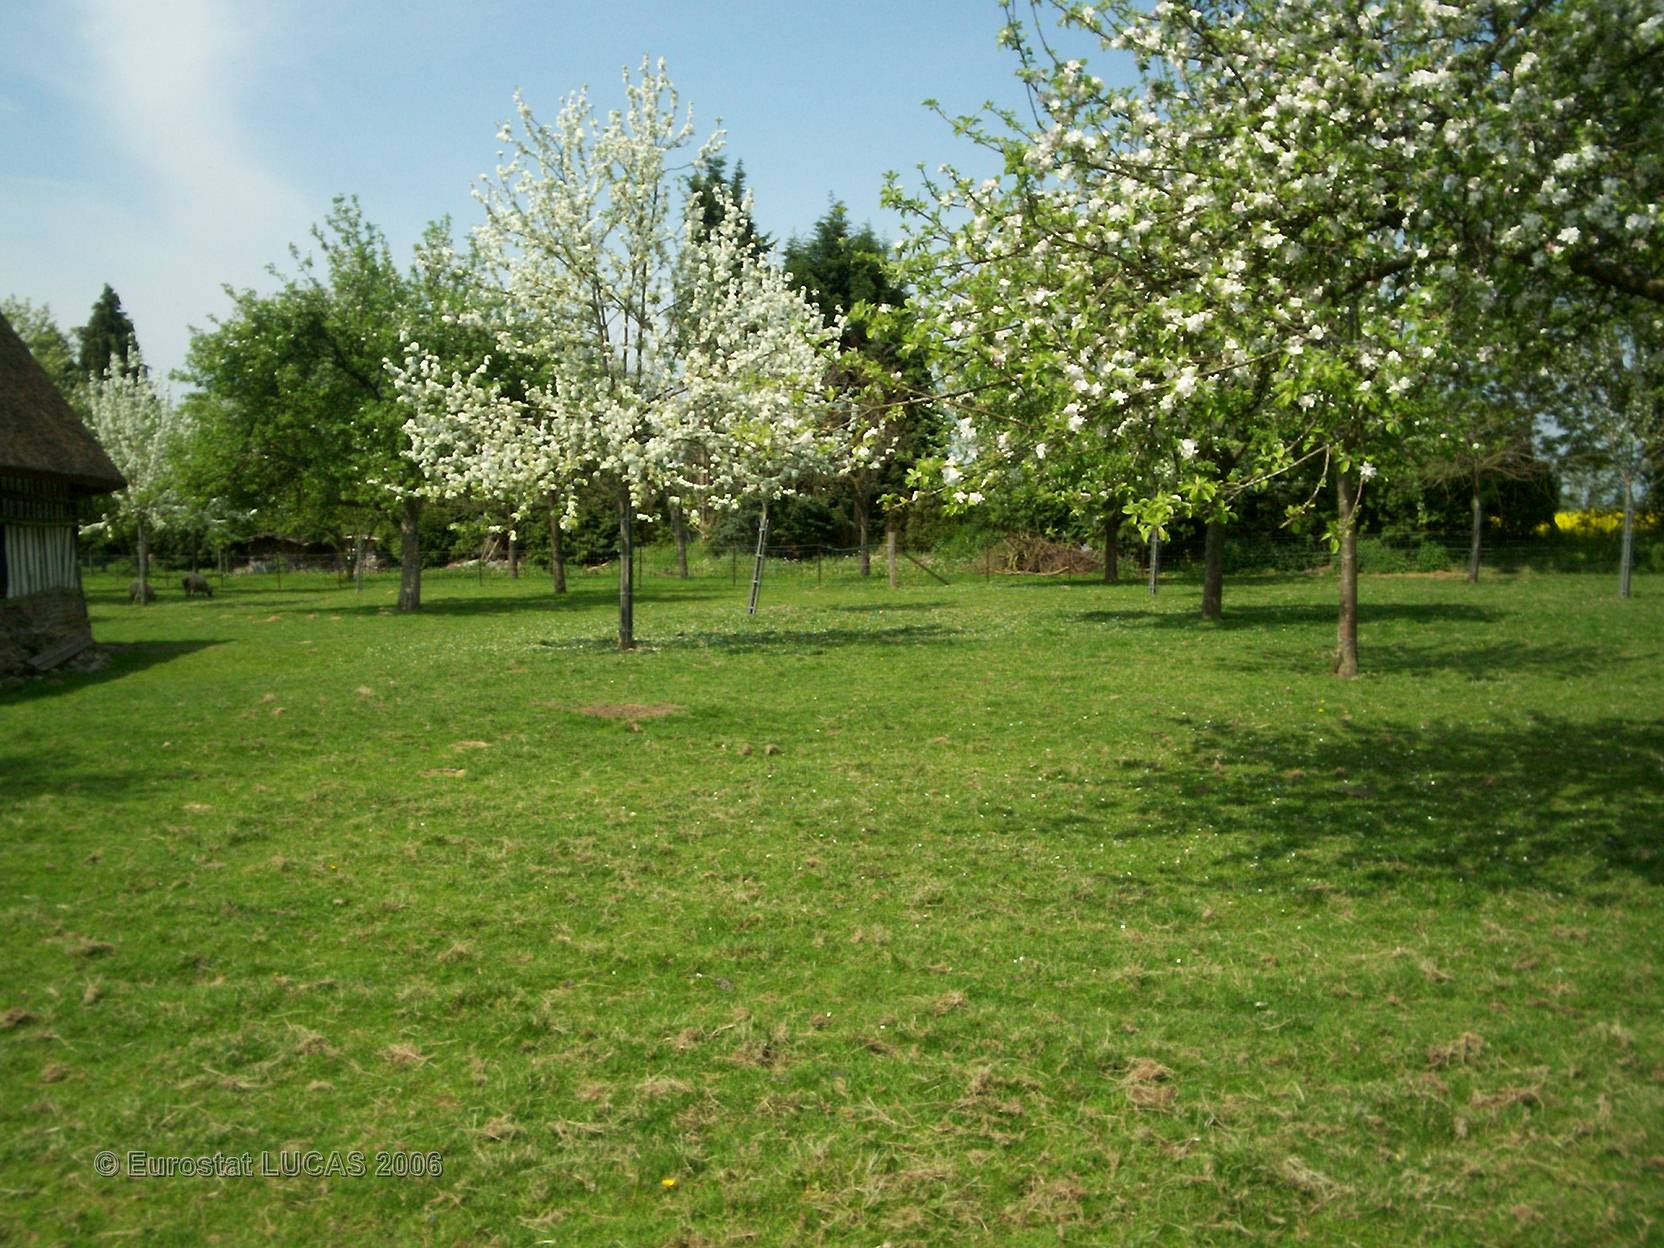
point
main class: Grassland
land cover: Grassland with sparse tree/shrub cover
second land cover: Apple fruit
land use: Agriculture (excluding fallow land and kitchen gardens)
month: May
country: FR
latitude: 49.2063
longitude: 0.4891
